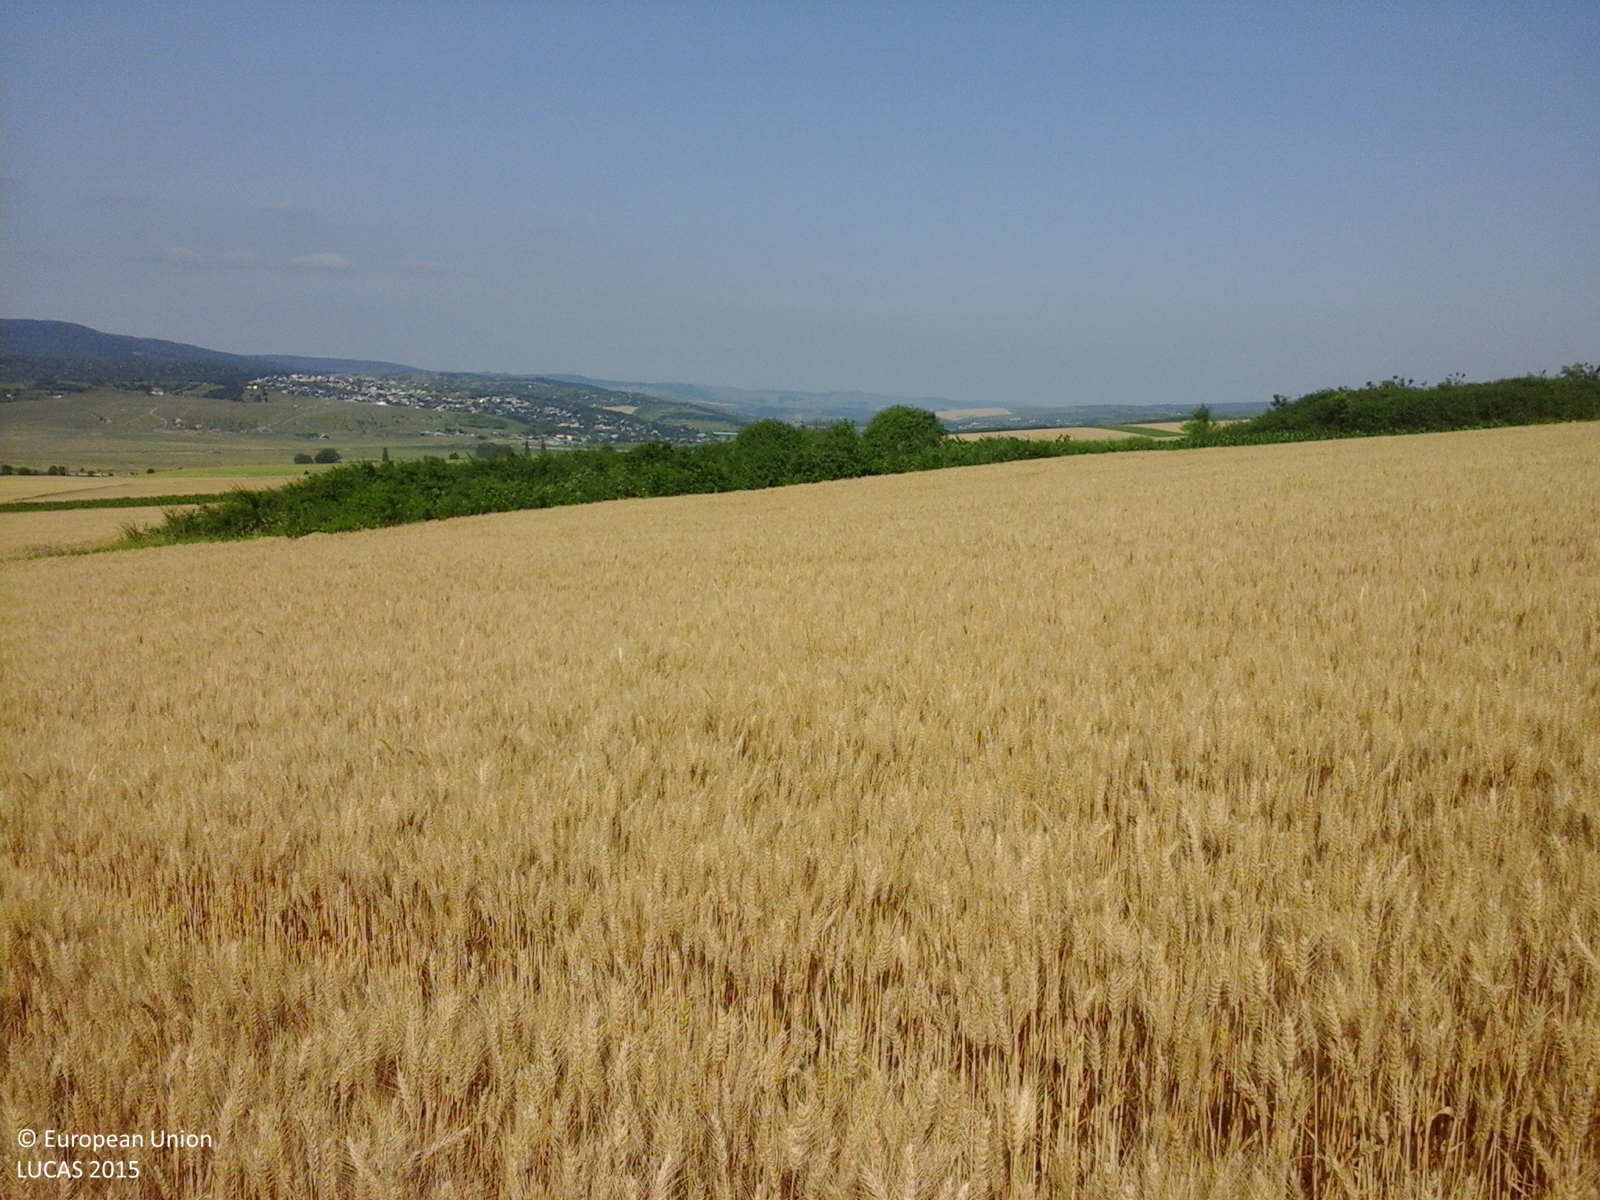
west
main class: Cropland
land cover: Common wheat
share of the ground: > 75 %
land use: Agriculture (excluding fallow land and kitchen gardens)
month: June
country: RO
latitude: 46.6308
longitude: 27.6853
